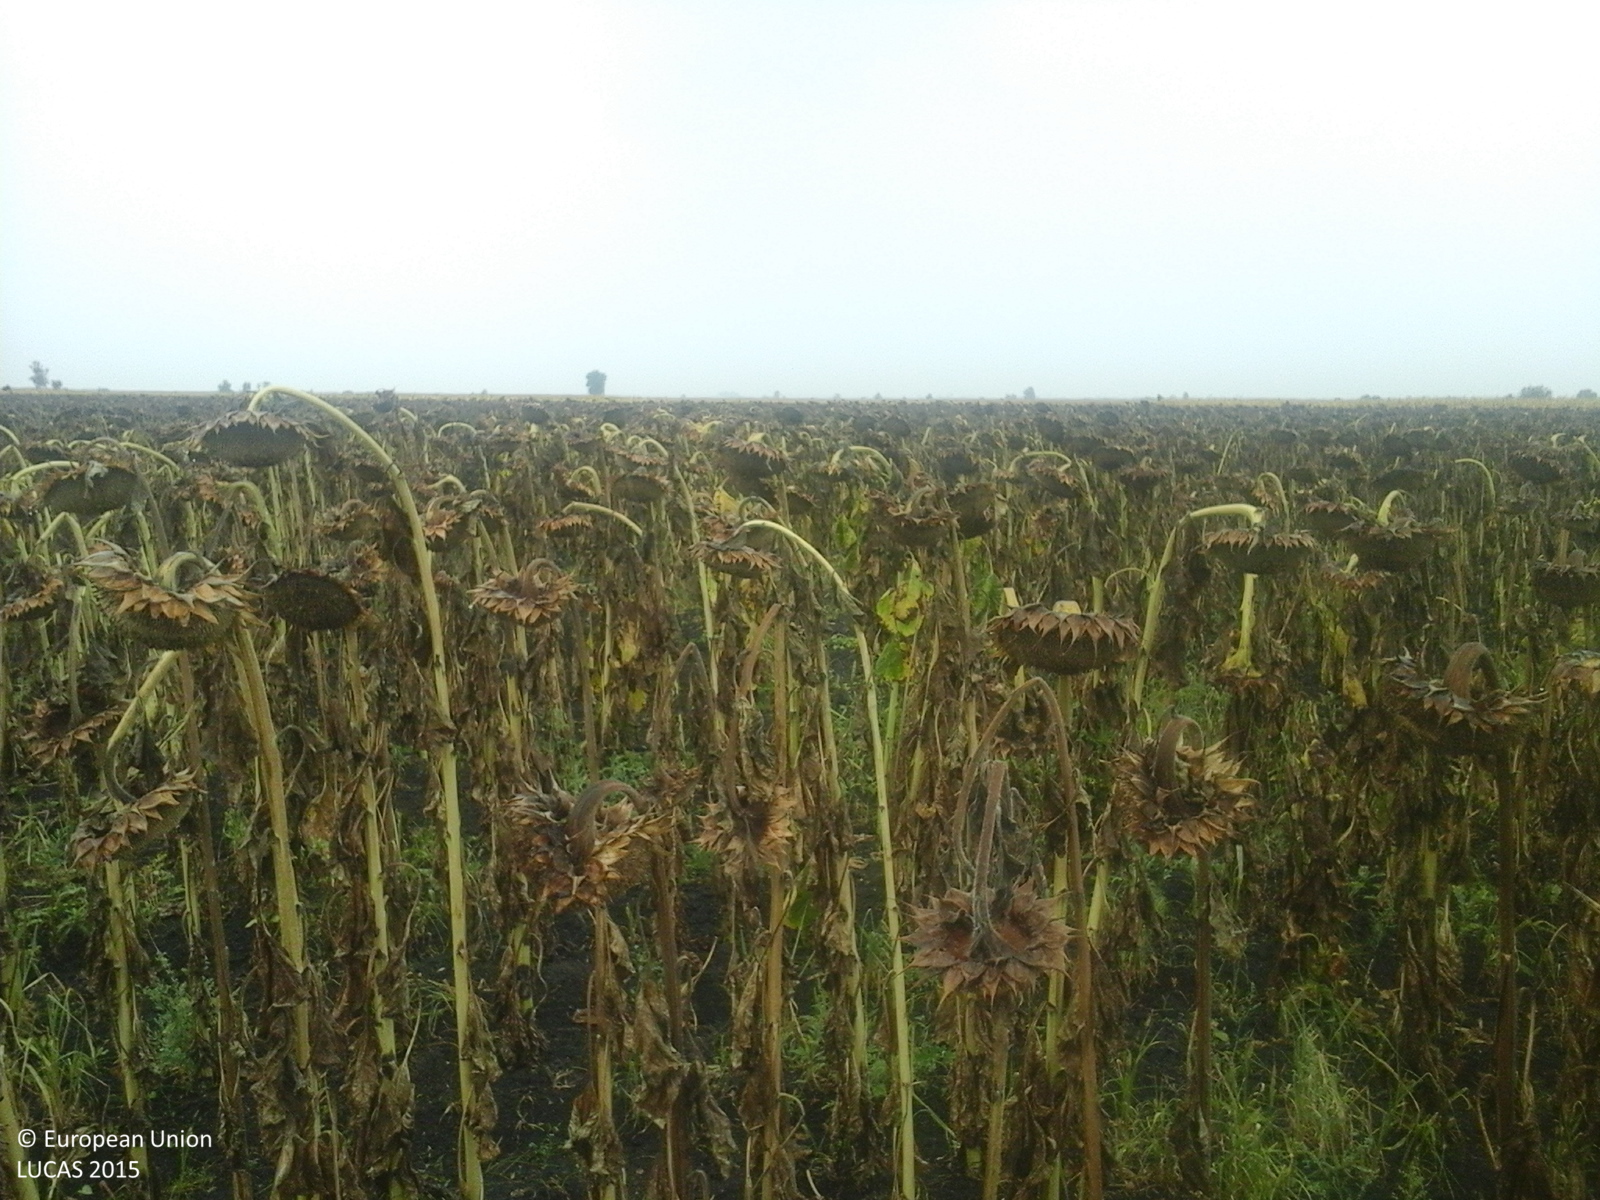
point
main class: Cropland
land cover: Sunflower
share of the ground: > 75 %
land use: Agriculture (excluding fallow land and kitchen gardens)
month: September
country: RO
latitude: 47.7392
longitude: 22.5547
